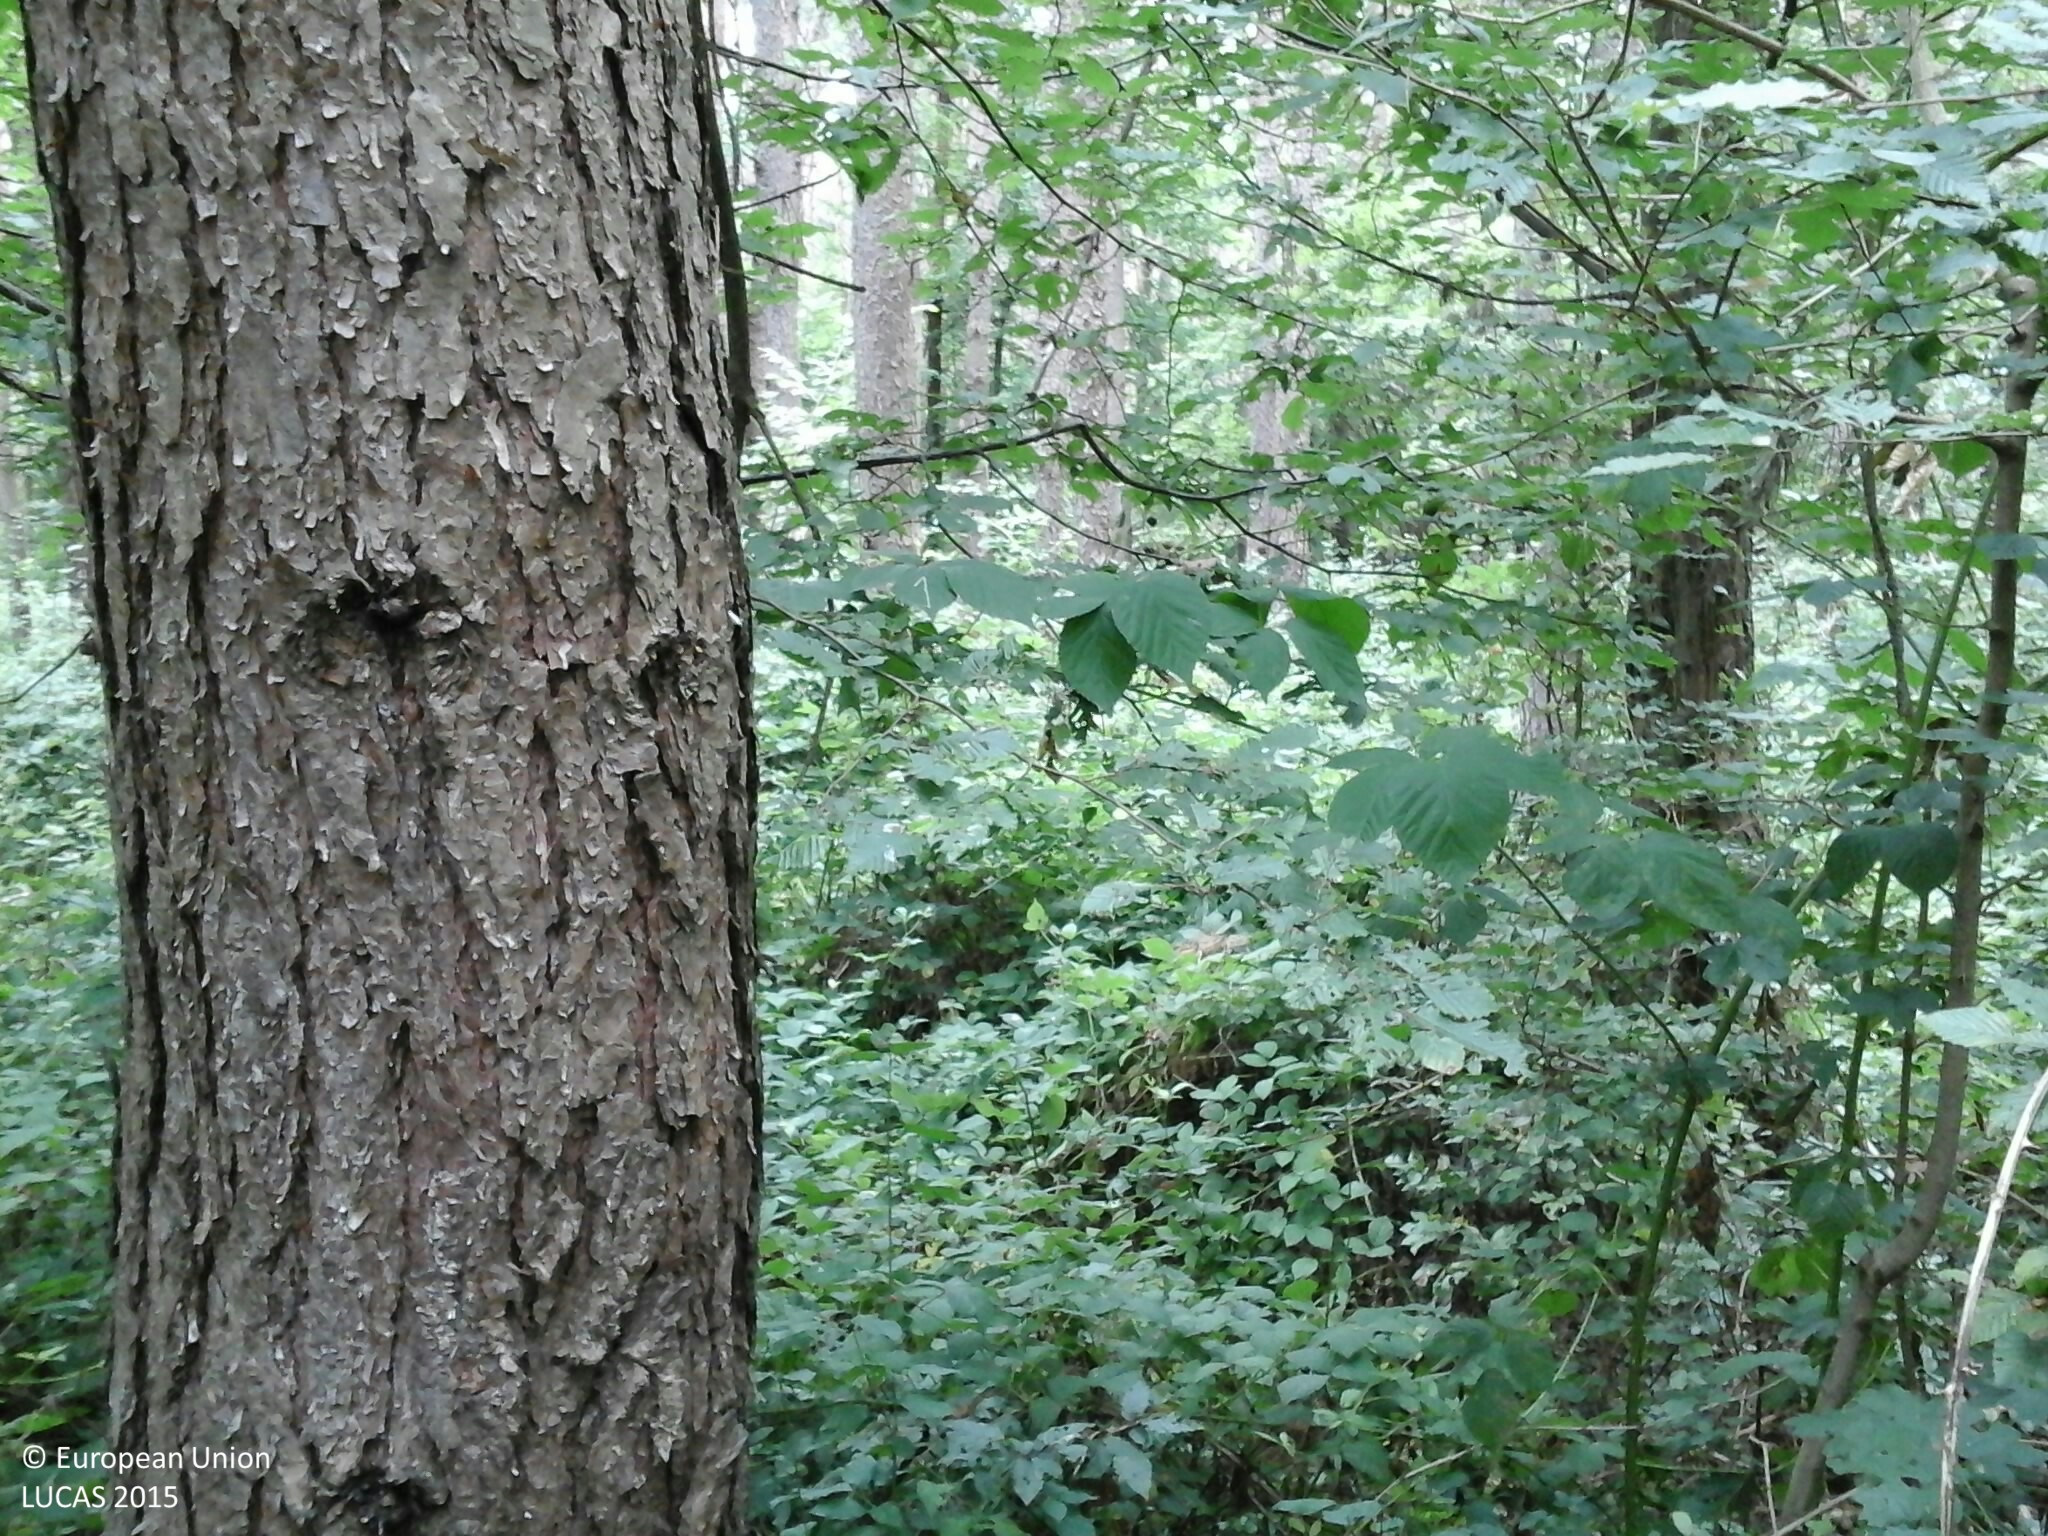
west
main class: Woodland
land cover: Other coniferous woodland
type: hemiboreal forest and nemoral coniferous forest and mixed broadleaved-coniferous forest
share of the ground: > 75 %
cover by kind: coniferous forest trees 60 %, shrubs 30 %, herbaceous plants 10 %
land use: Forestry
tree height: > 5 m
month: July
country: HU
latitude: 46.7476
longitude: 16.5337
